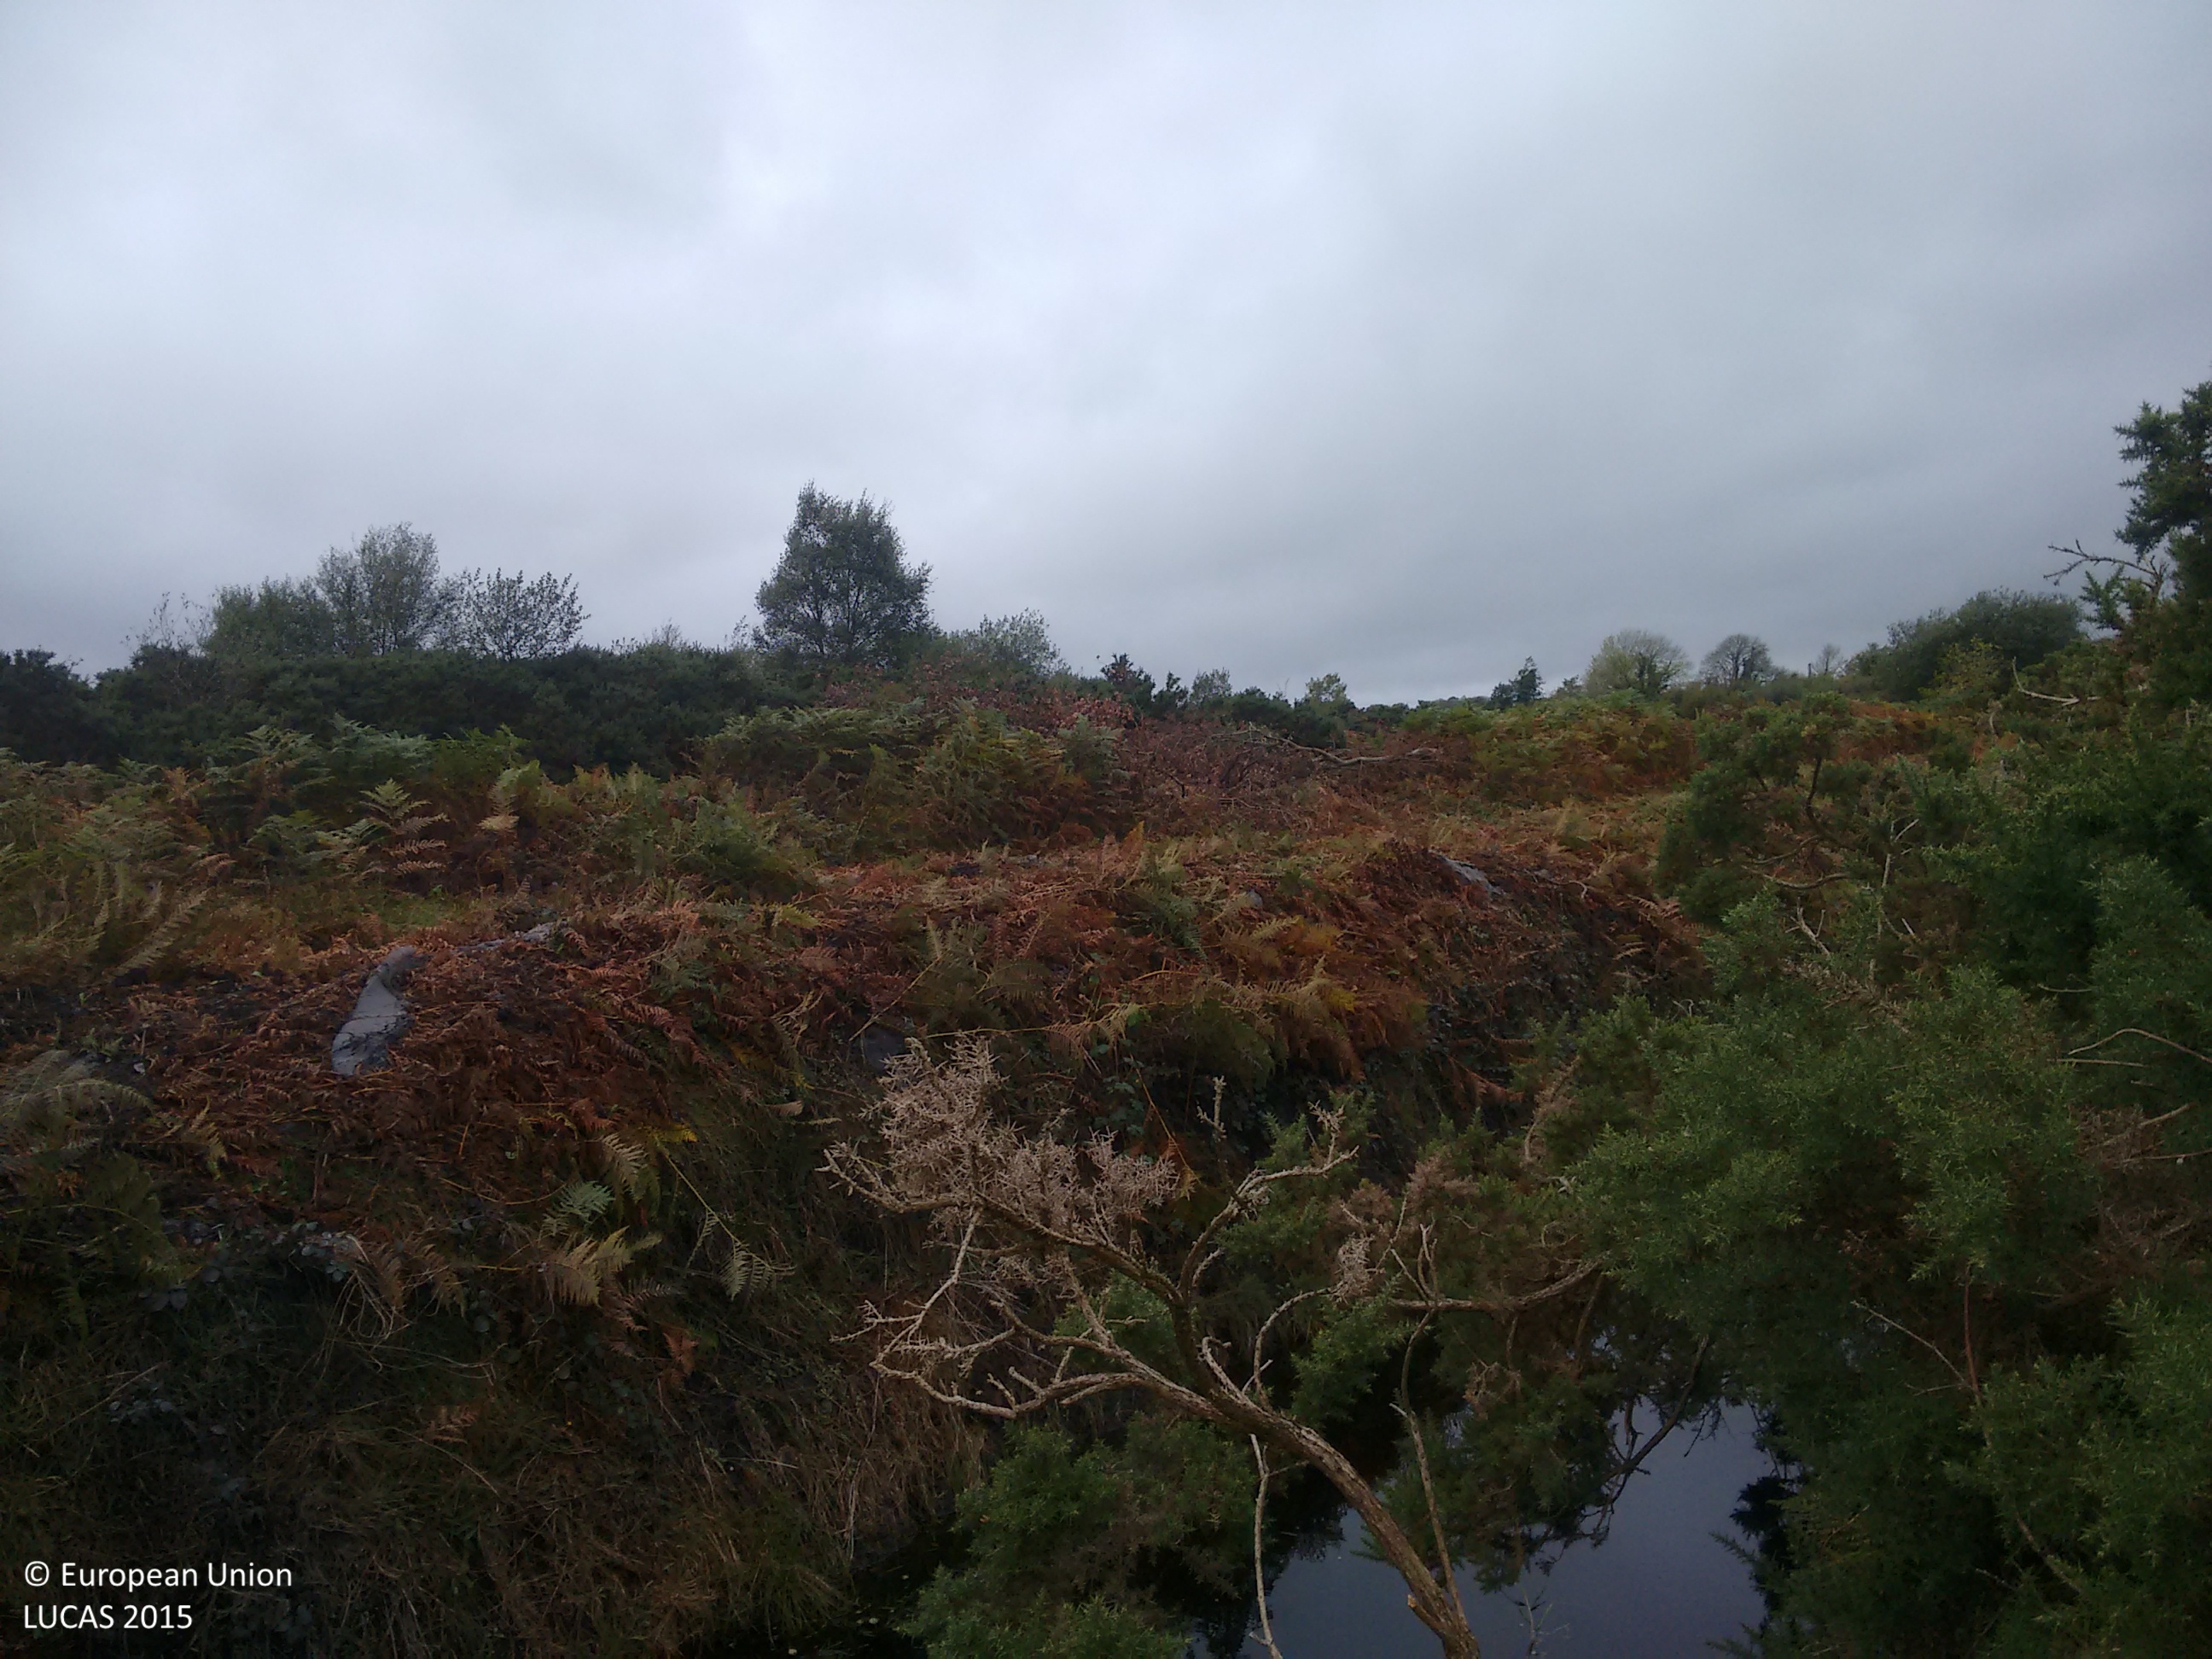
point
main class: Shrubland
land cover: Shrubland with sparse tree cover
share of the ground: > 75 %
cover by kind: shrubs 75 %, herbaceous plants 20 %, broadleaved forest trees 5 %
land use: Semi-natural and natural areas not in use
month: October
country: IE
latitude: 53.1942
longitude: -7.9093
